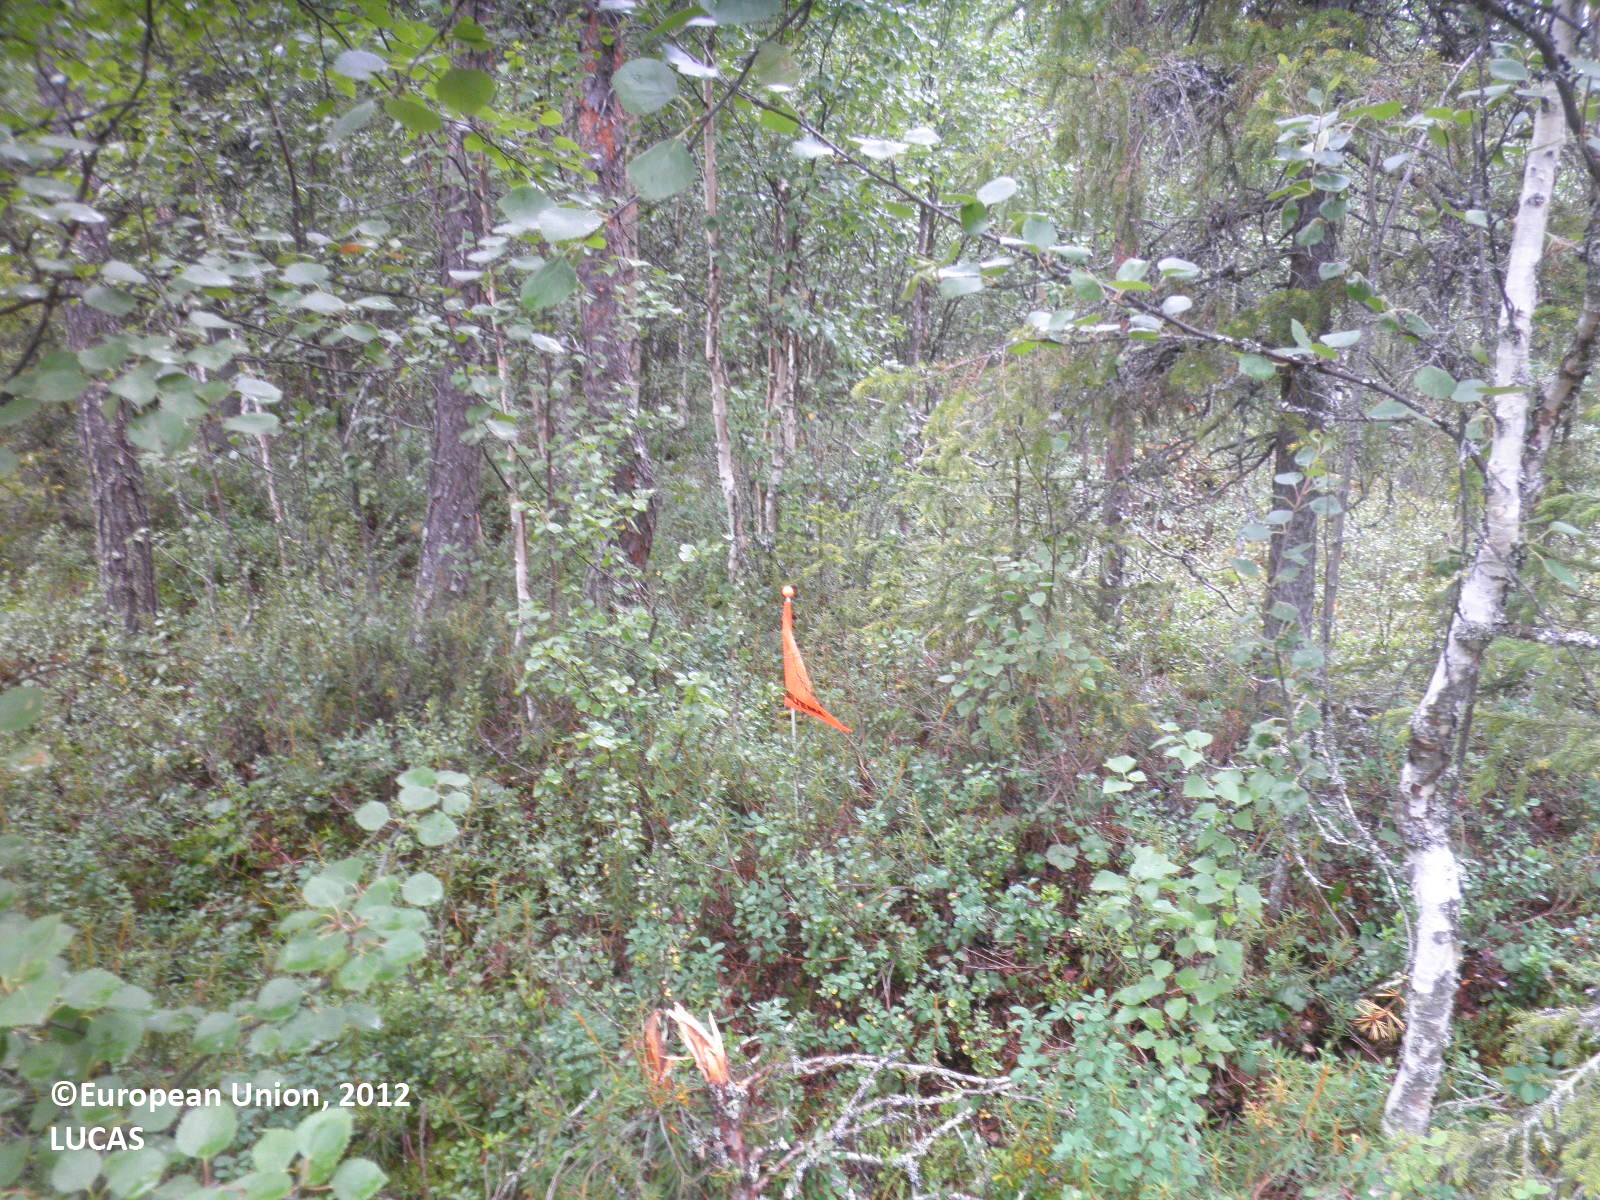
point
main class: Woodland
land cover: Pine dominated mixed woodland
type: boreal forest
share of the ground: 50 - 75 %
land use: Forestry
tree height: > 5 m
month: July
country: FI
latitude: 66.8983
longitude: 28.9040
